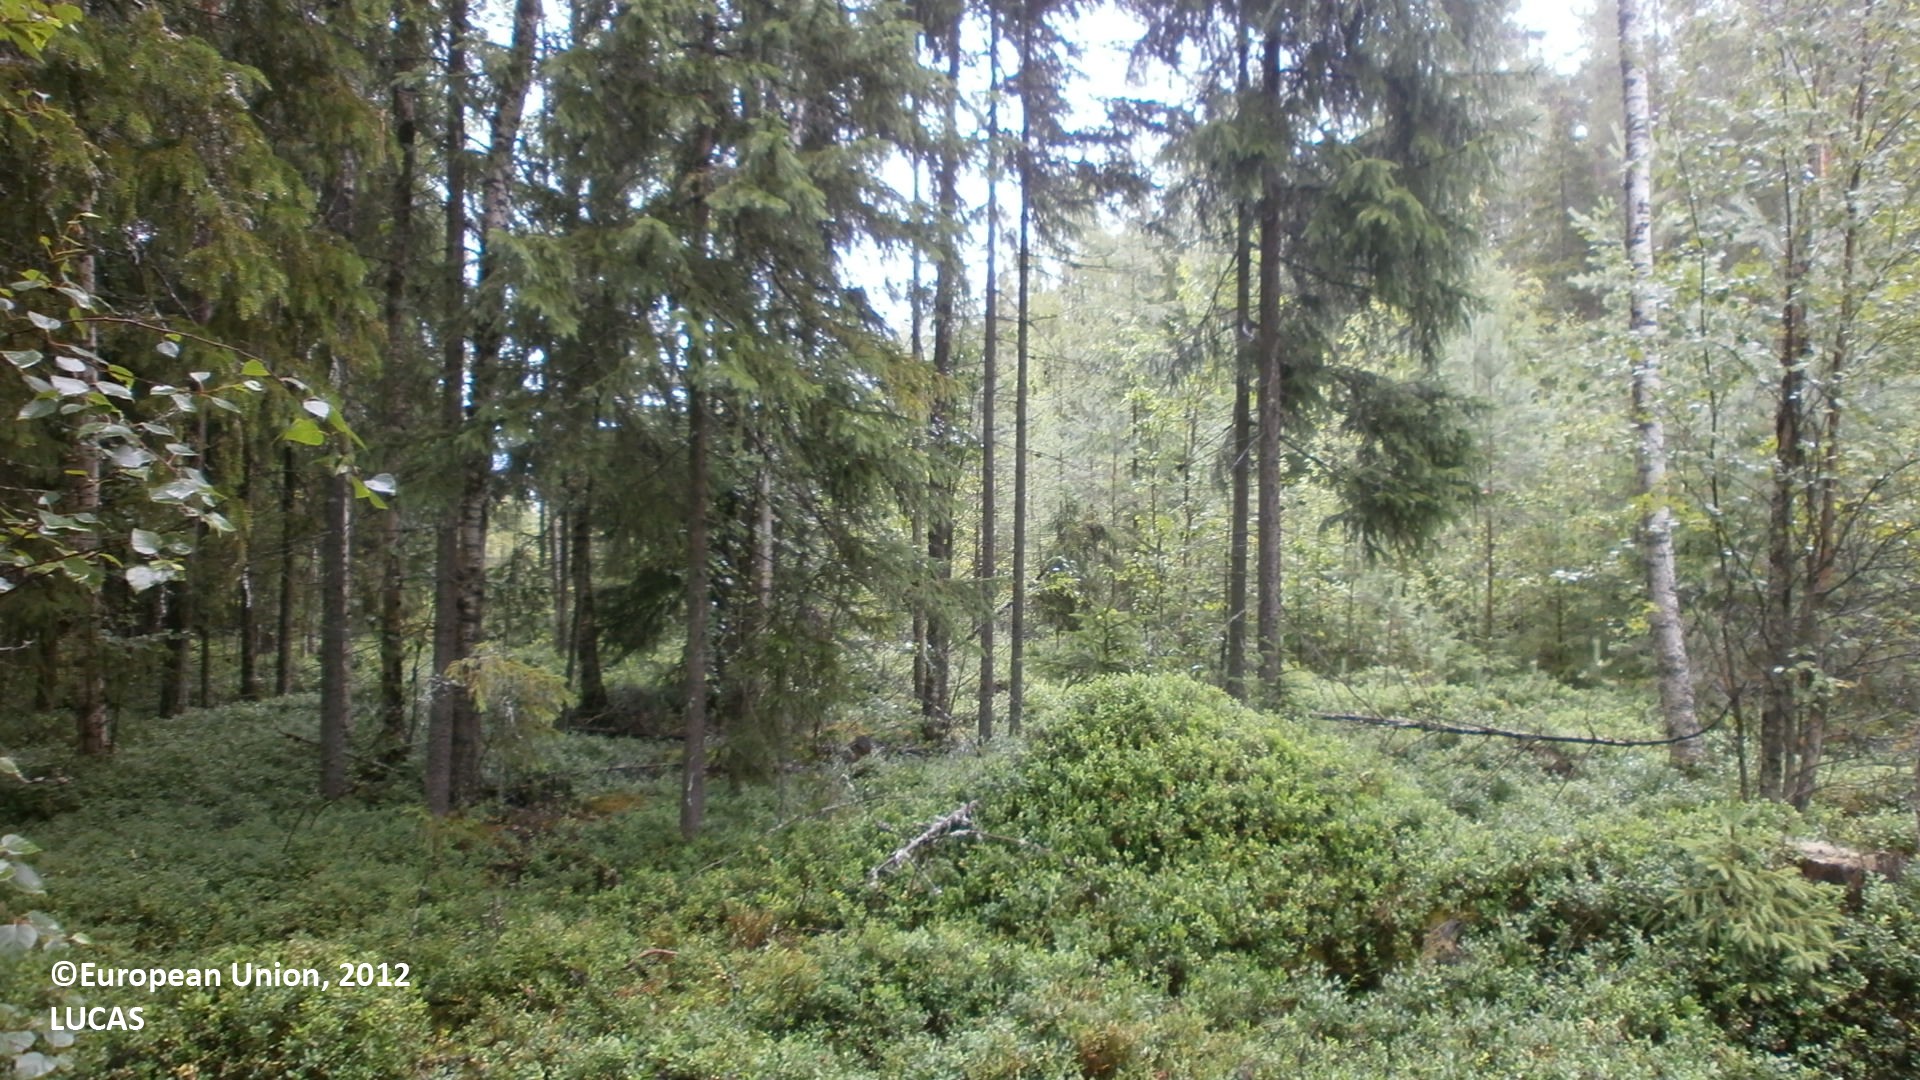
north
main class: Woodland
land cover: Spruce dominated mixed woodland
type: boreal forest
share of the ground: > 75 %
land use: Forestry
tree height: > 5 m
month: July
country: FI
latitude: 64.0522
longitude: 23.7646
